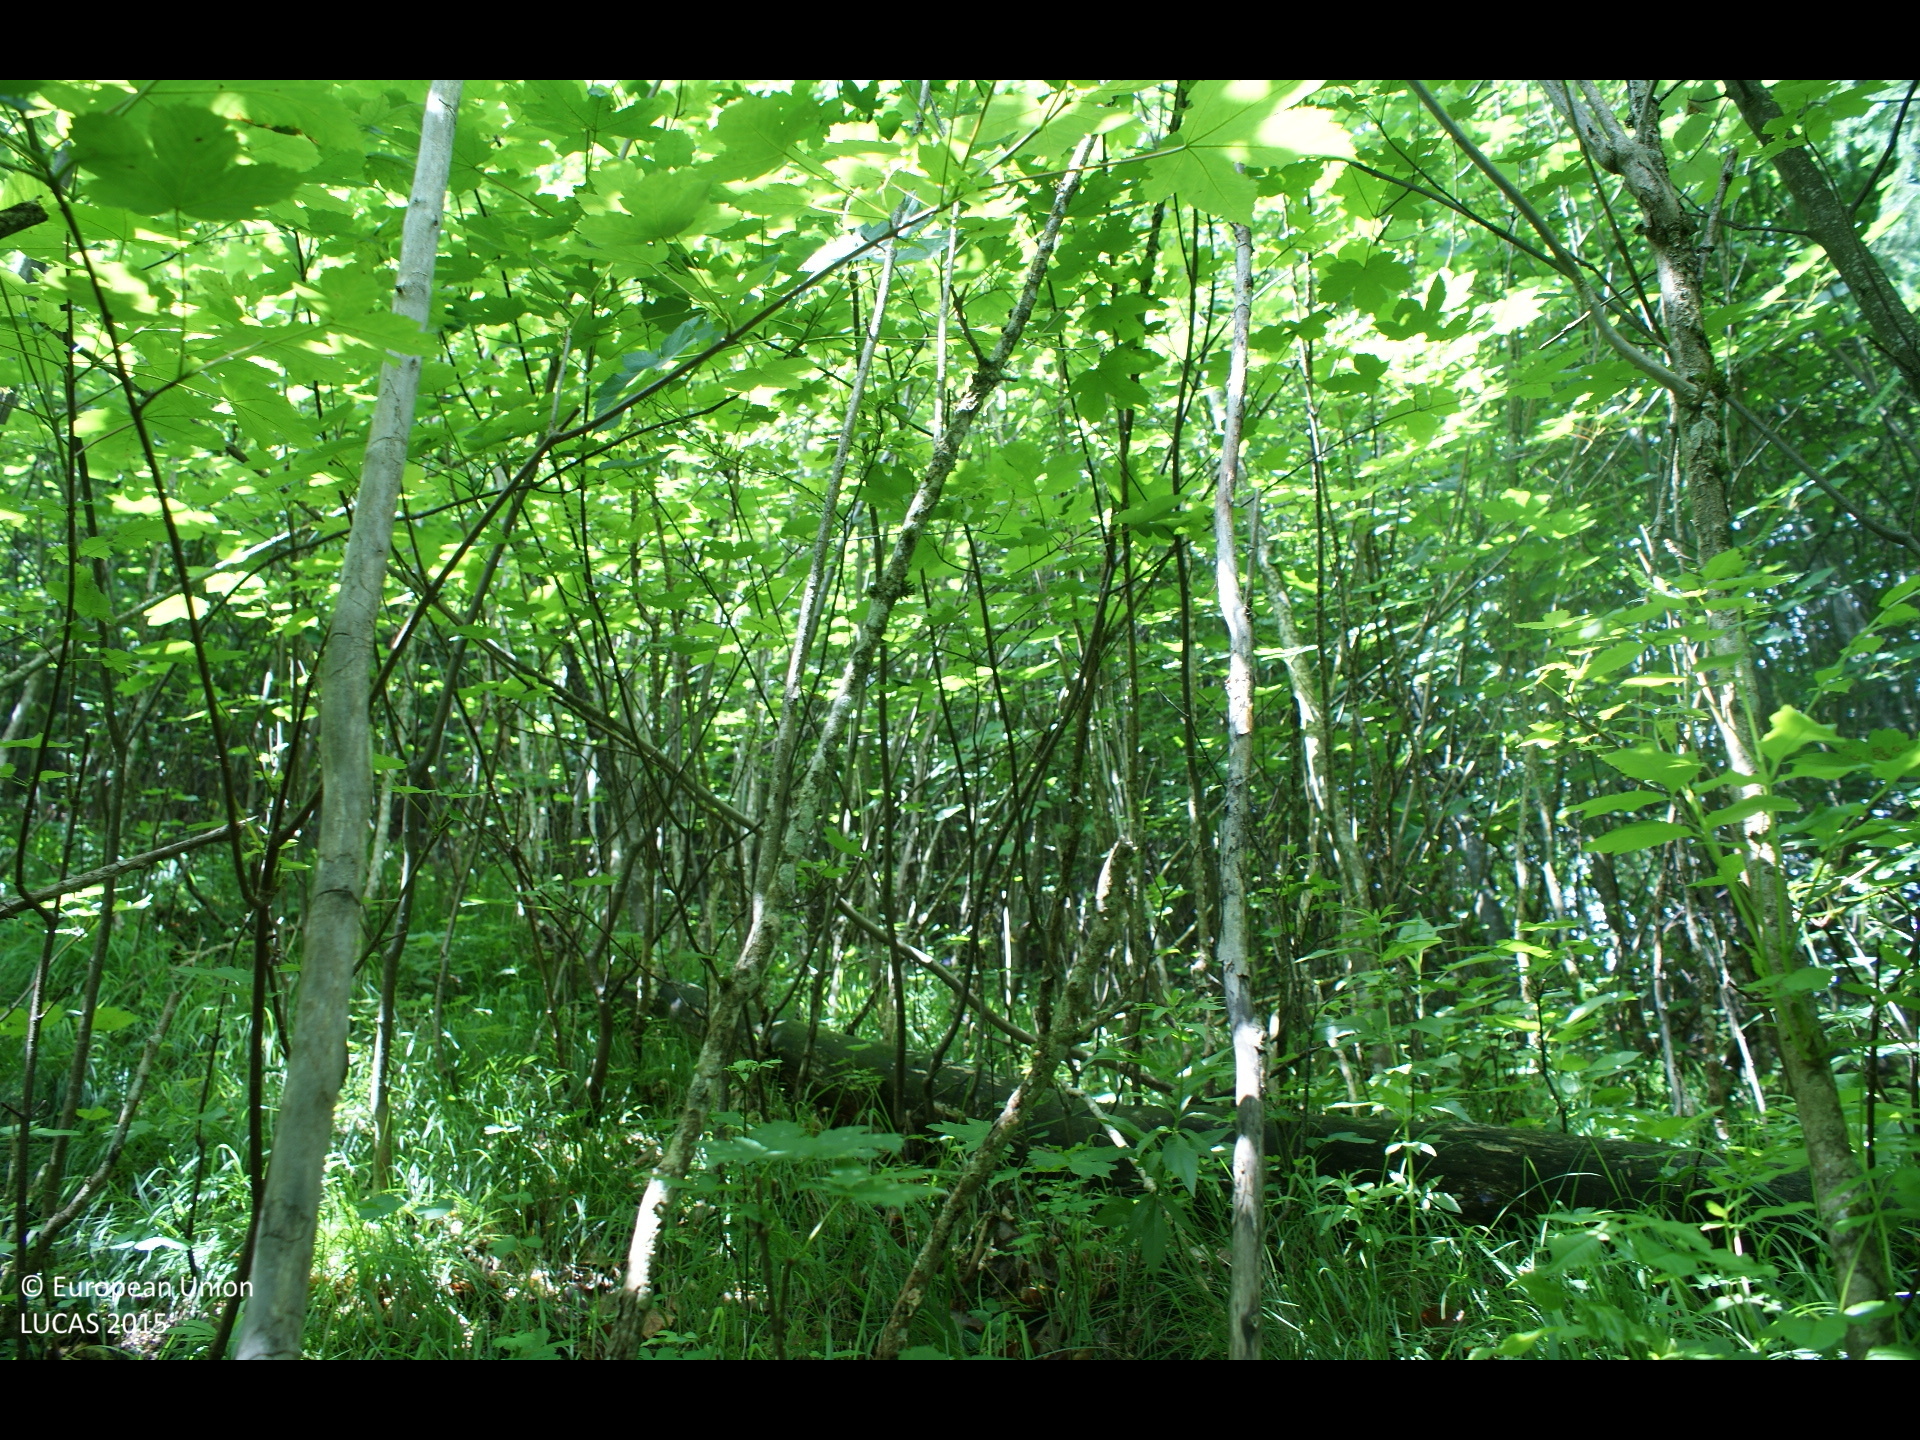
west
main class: Woodland
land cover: Broadleaved woodland
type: beech forest
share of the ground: > 75 %
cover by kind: broadleaved forest trees 90 %, coniferous forest trees 5 %, herbaceous plants 5 %
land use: Forestry
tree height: < 5 m
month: June
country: AT
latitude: 47.9405
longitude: 14.3238
